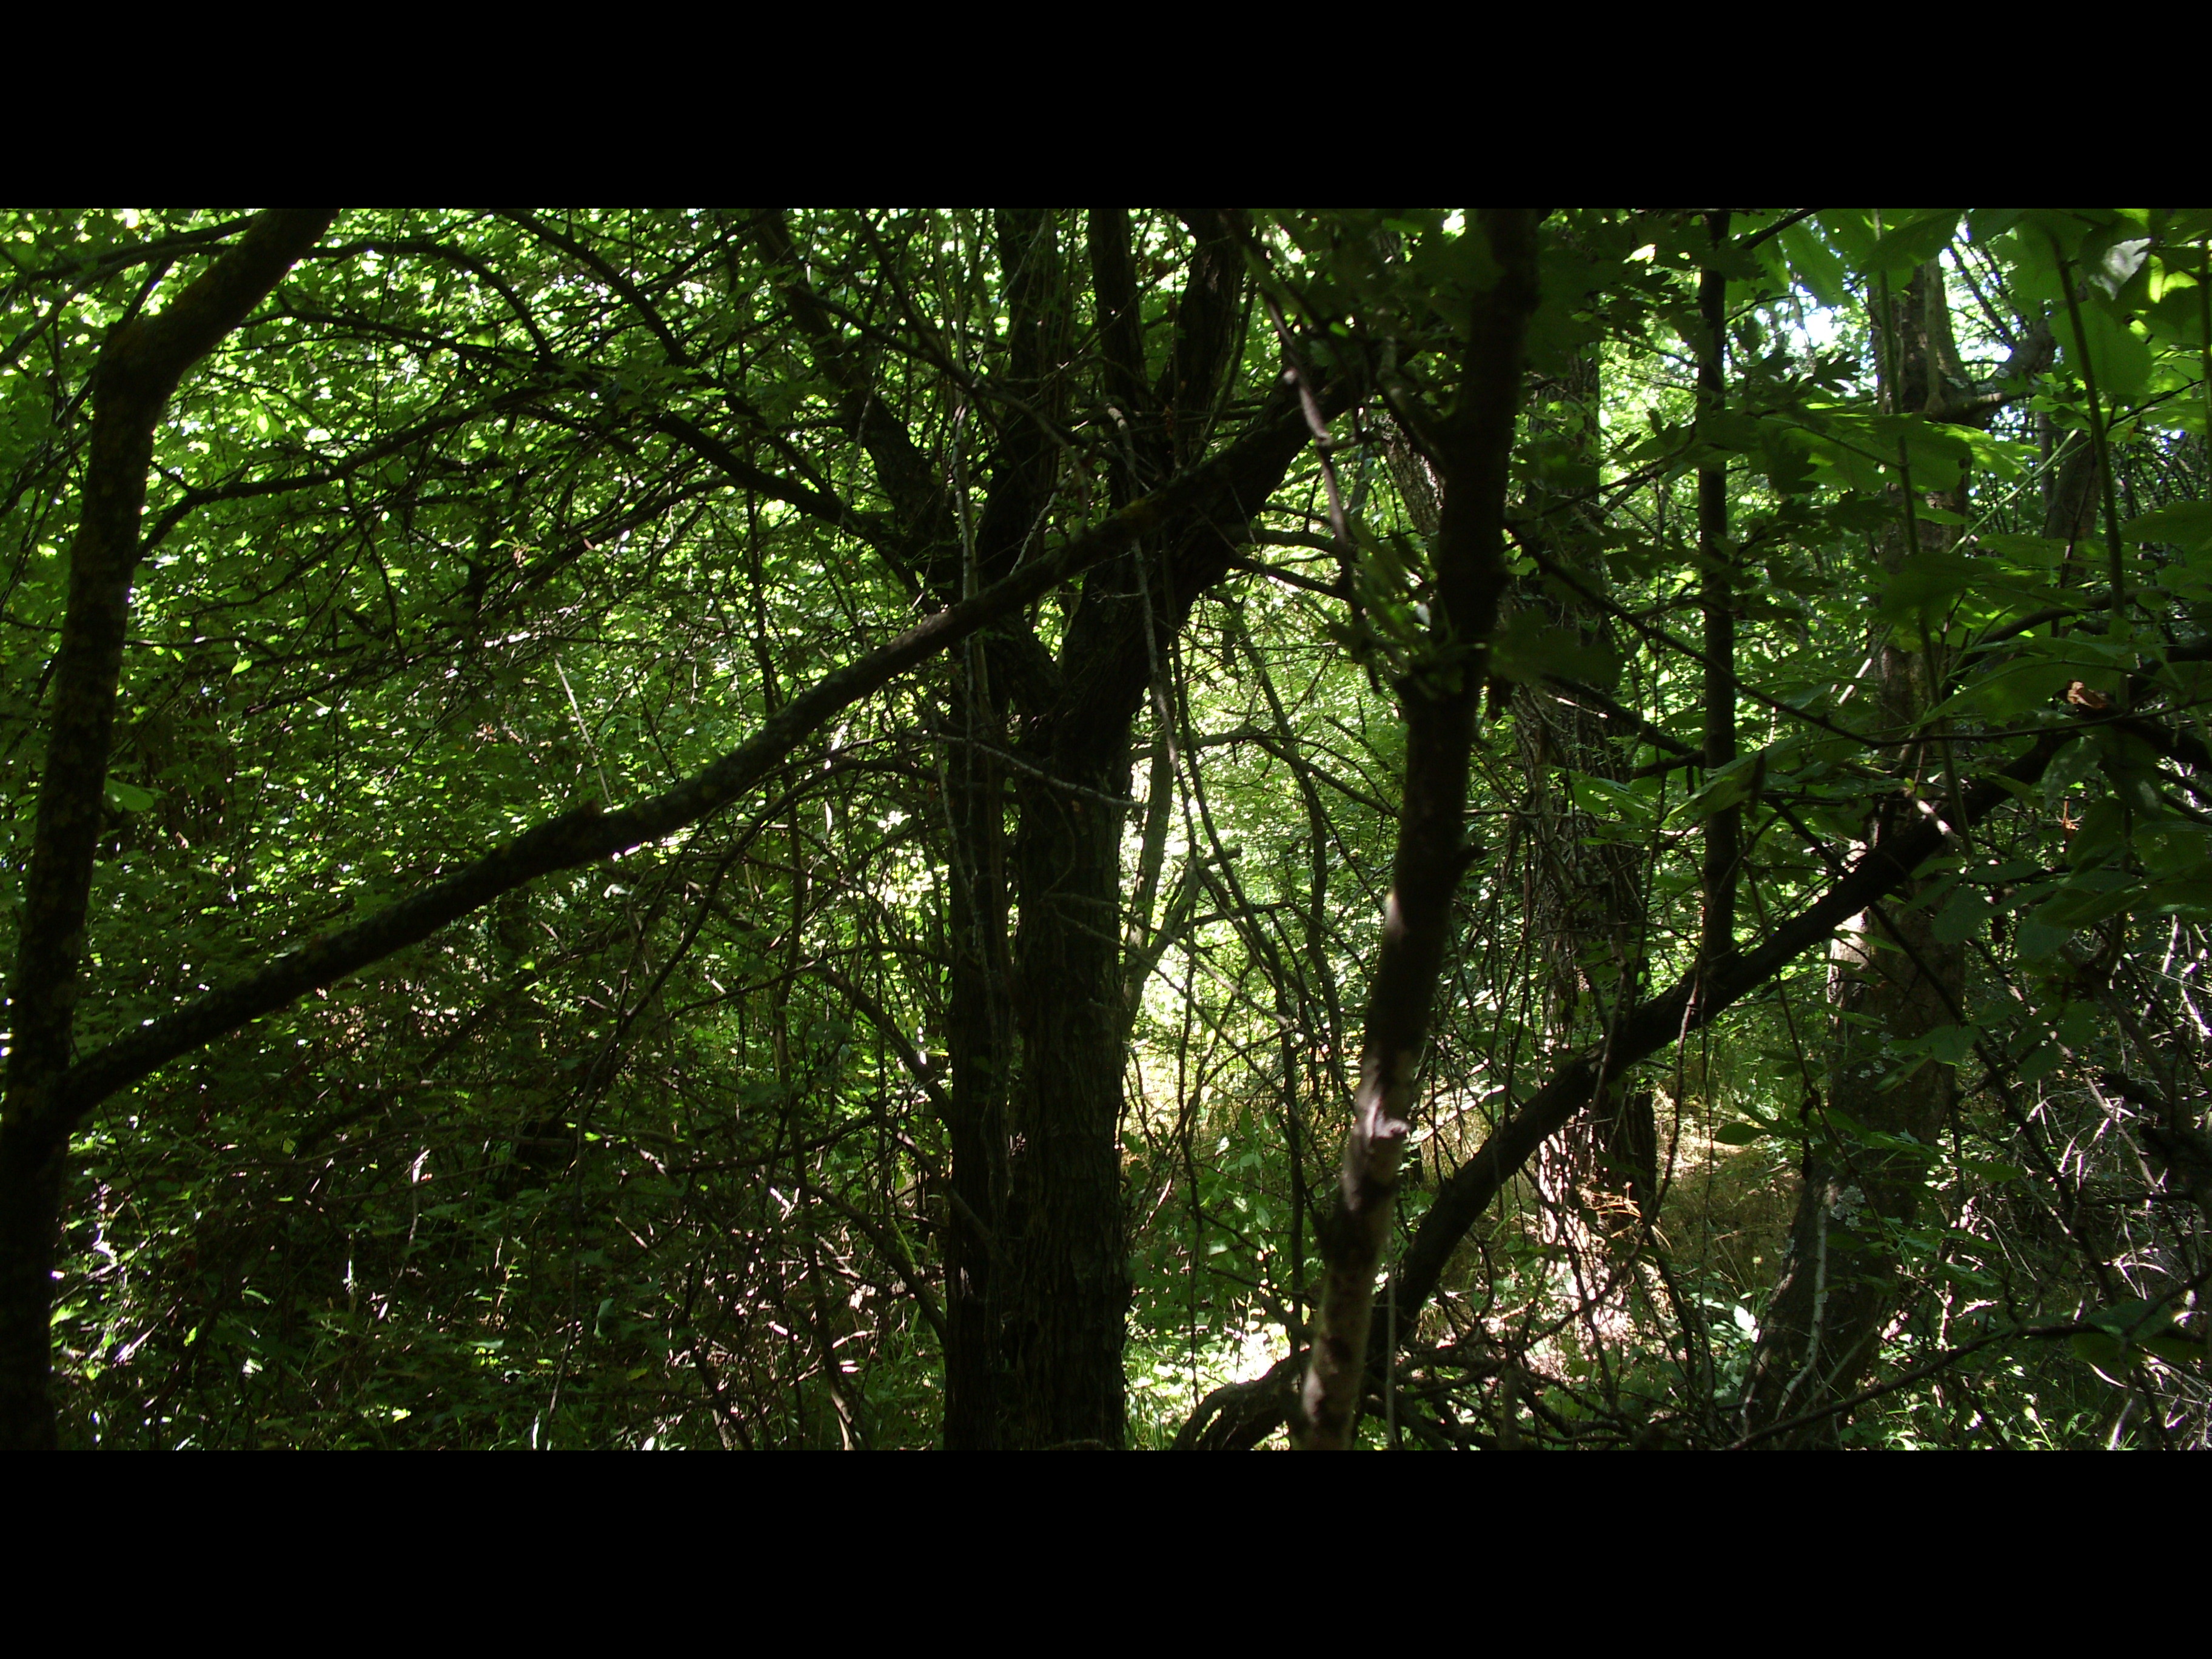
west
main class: Woodland
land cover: Broadleaved woodland
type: mesophytic deciduous forest
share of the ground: > 75 %
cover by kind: broadleaved forest trees 95 %, shrubs 5 %
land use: Forestry
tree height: > 5 m
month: June
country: BG
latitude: 43.6207
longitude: 23.6926
